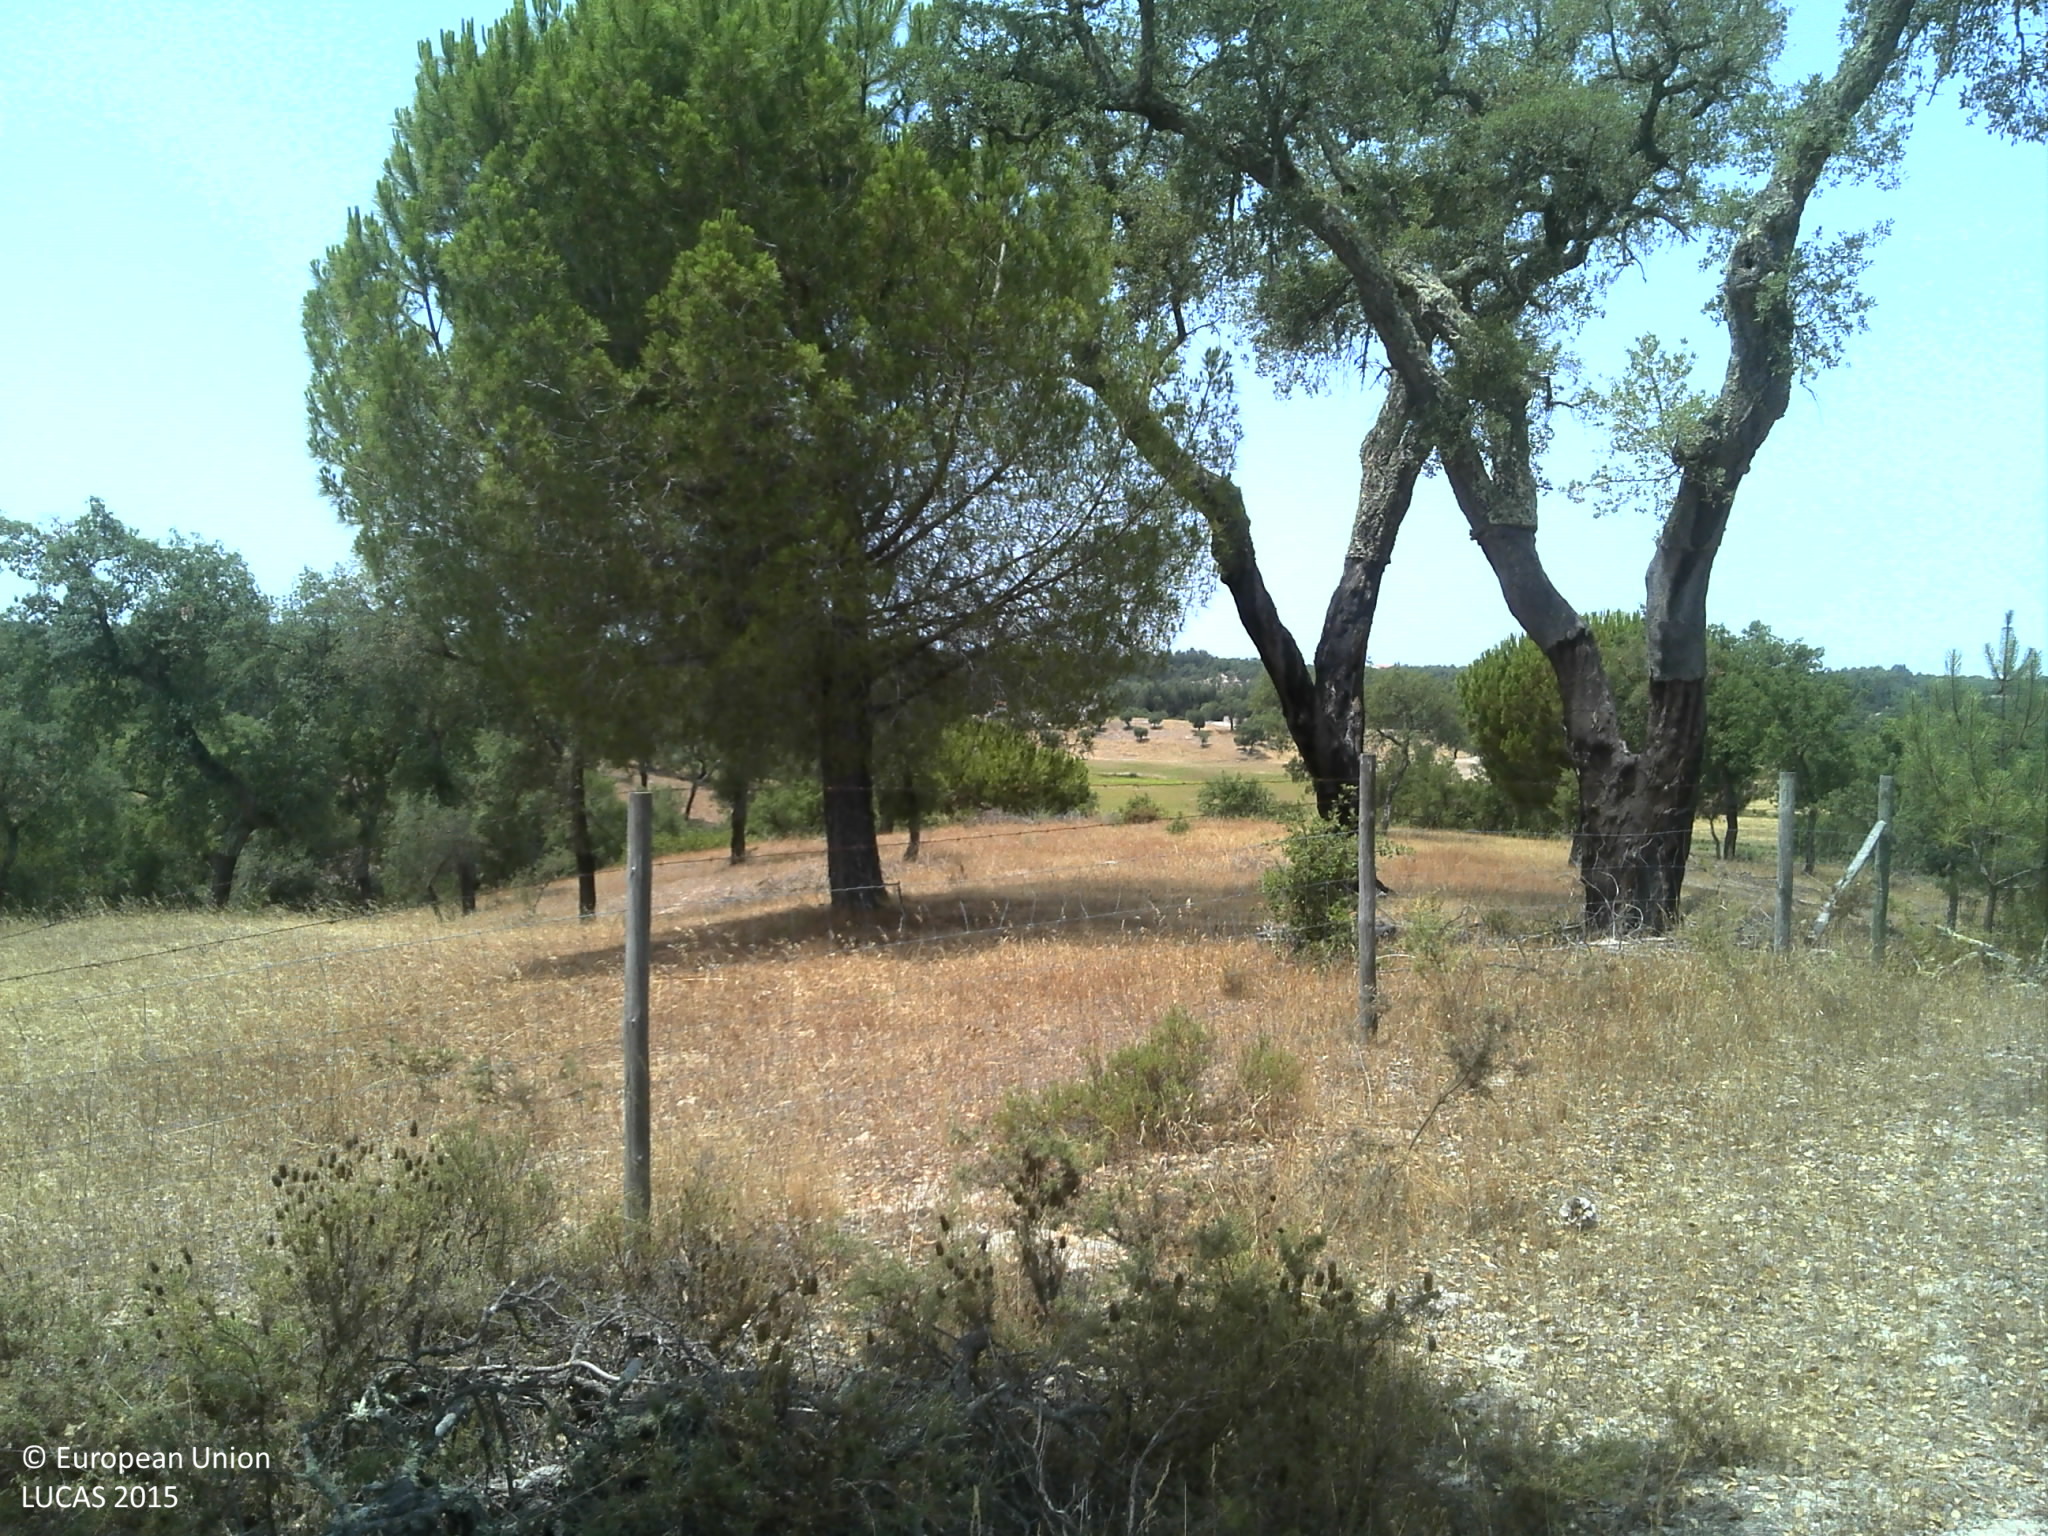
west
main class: Woodland
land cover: Broadleaved woodland
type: broadleaved evergreen forest
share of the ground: 25 - 50 %
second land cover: Grassland without tree/shrub cover
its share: 25 - 50 %
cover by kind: broadleaved forest trees 35 %, herbaceous plants 35 %, unconsolidated bare surface 30 %
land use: Forestry
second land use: Agriculture (excluding fallow land and kitchen gardens)
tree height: > 5 m
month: July
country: PT
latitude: 39.1518
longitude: -8.2376
